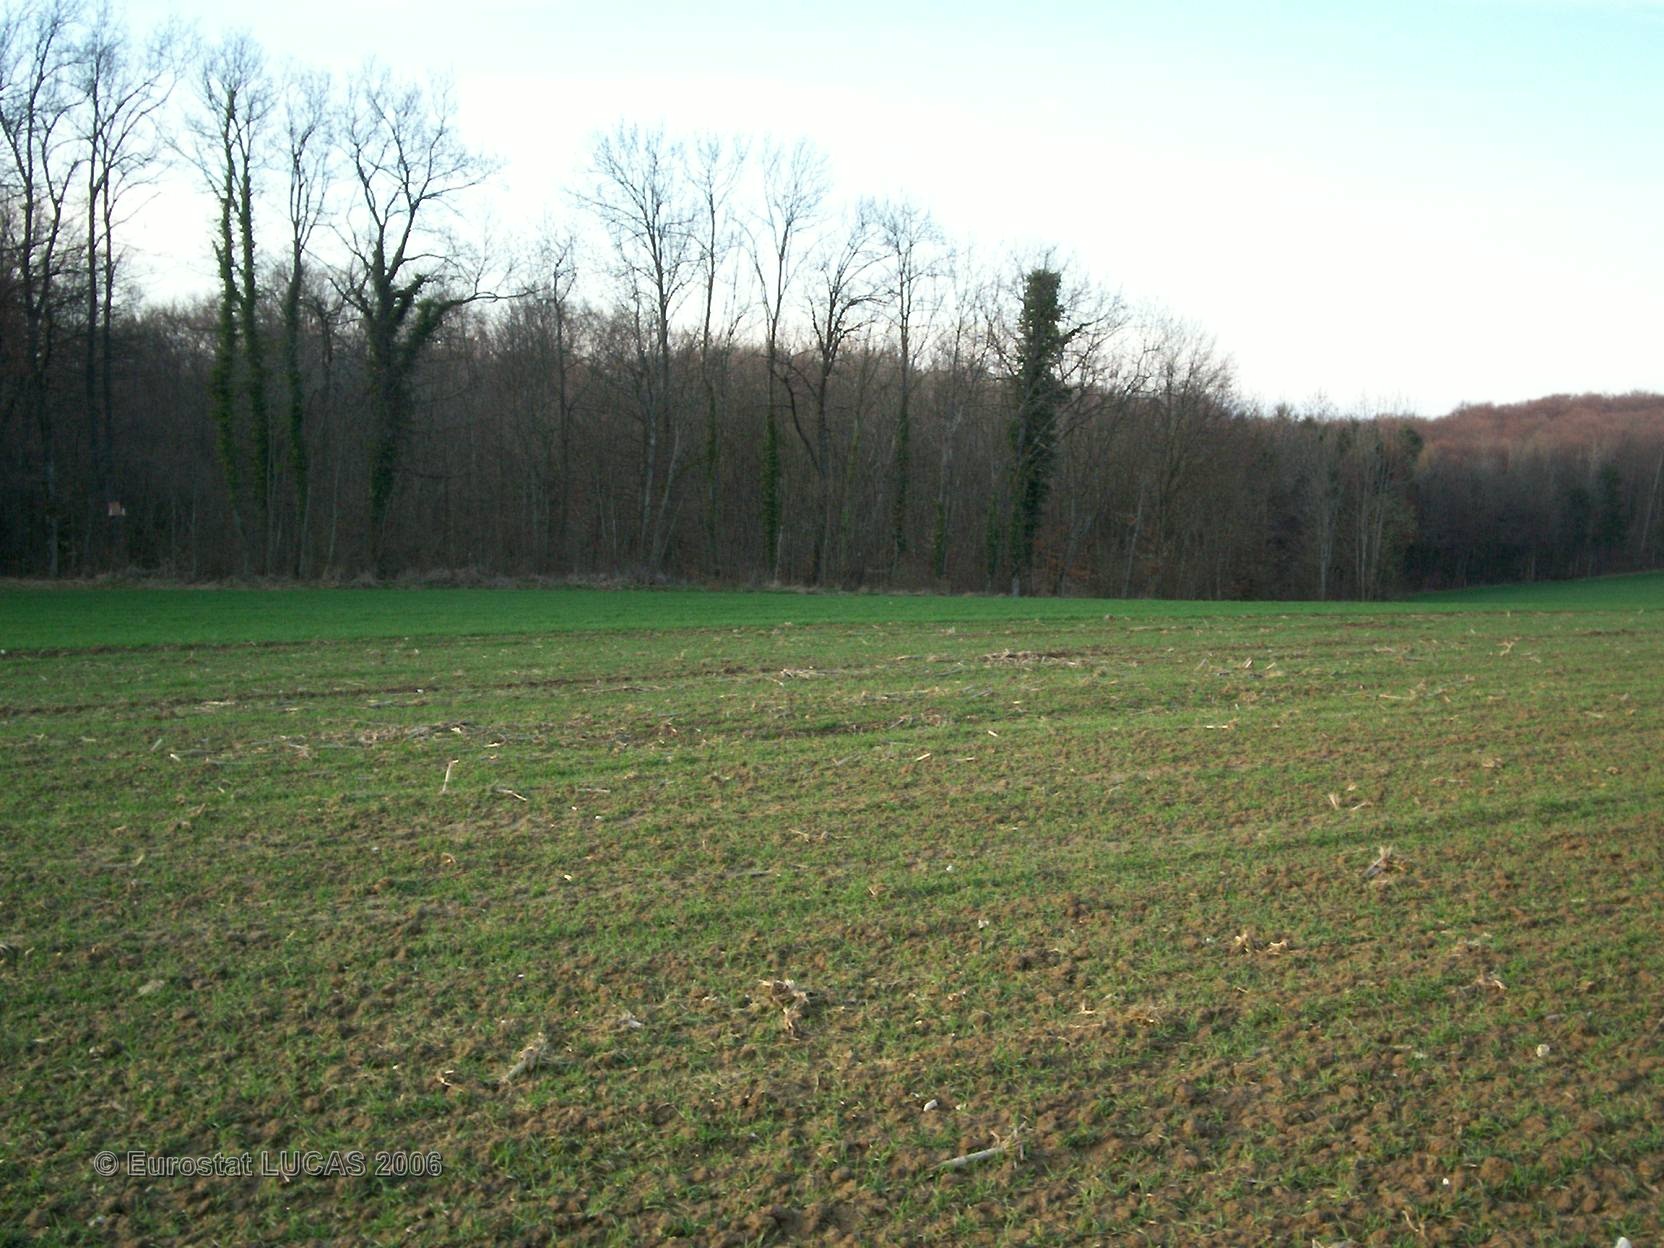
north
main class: Cropland
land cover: Common wheat
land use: Agriculture (excluding fallow land and kitchen gardens)
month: April
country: FR
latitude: 47.4621
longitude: 6.9905
